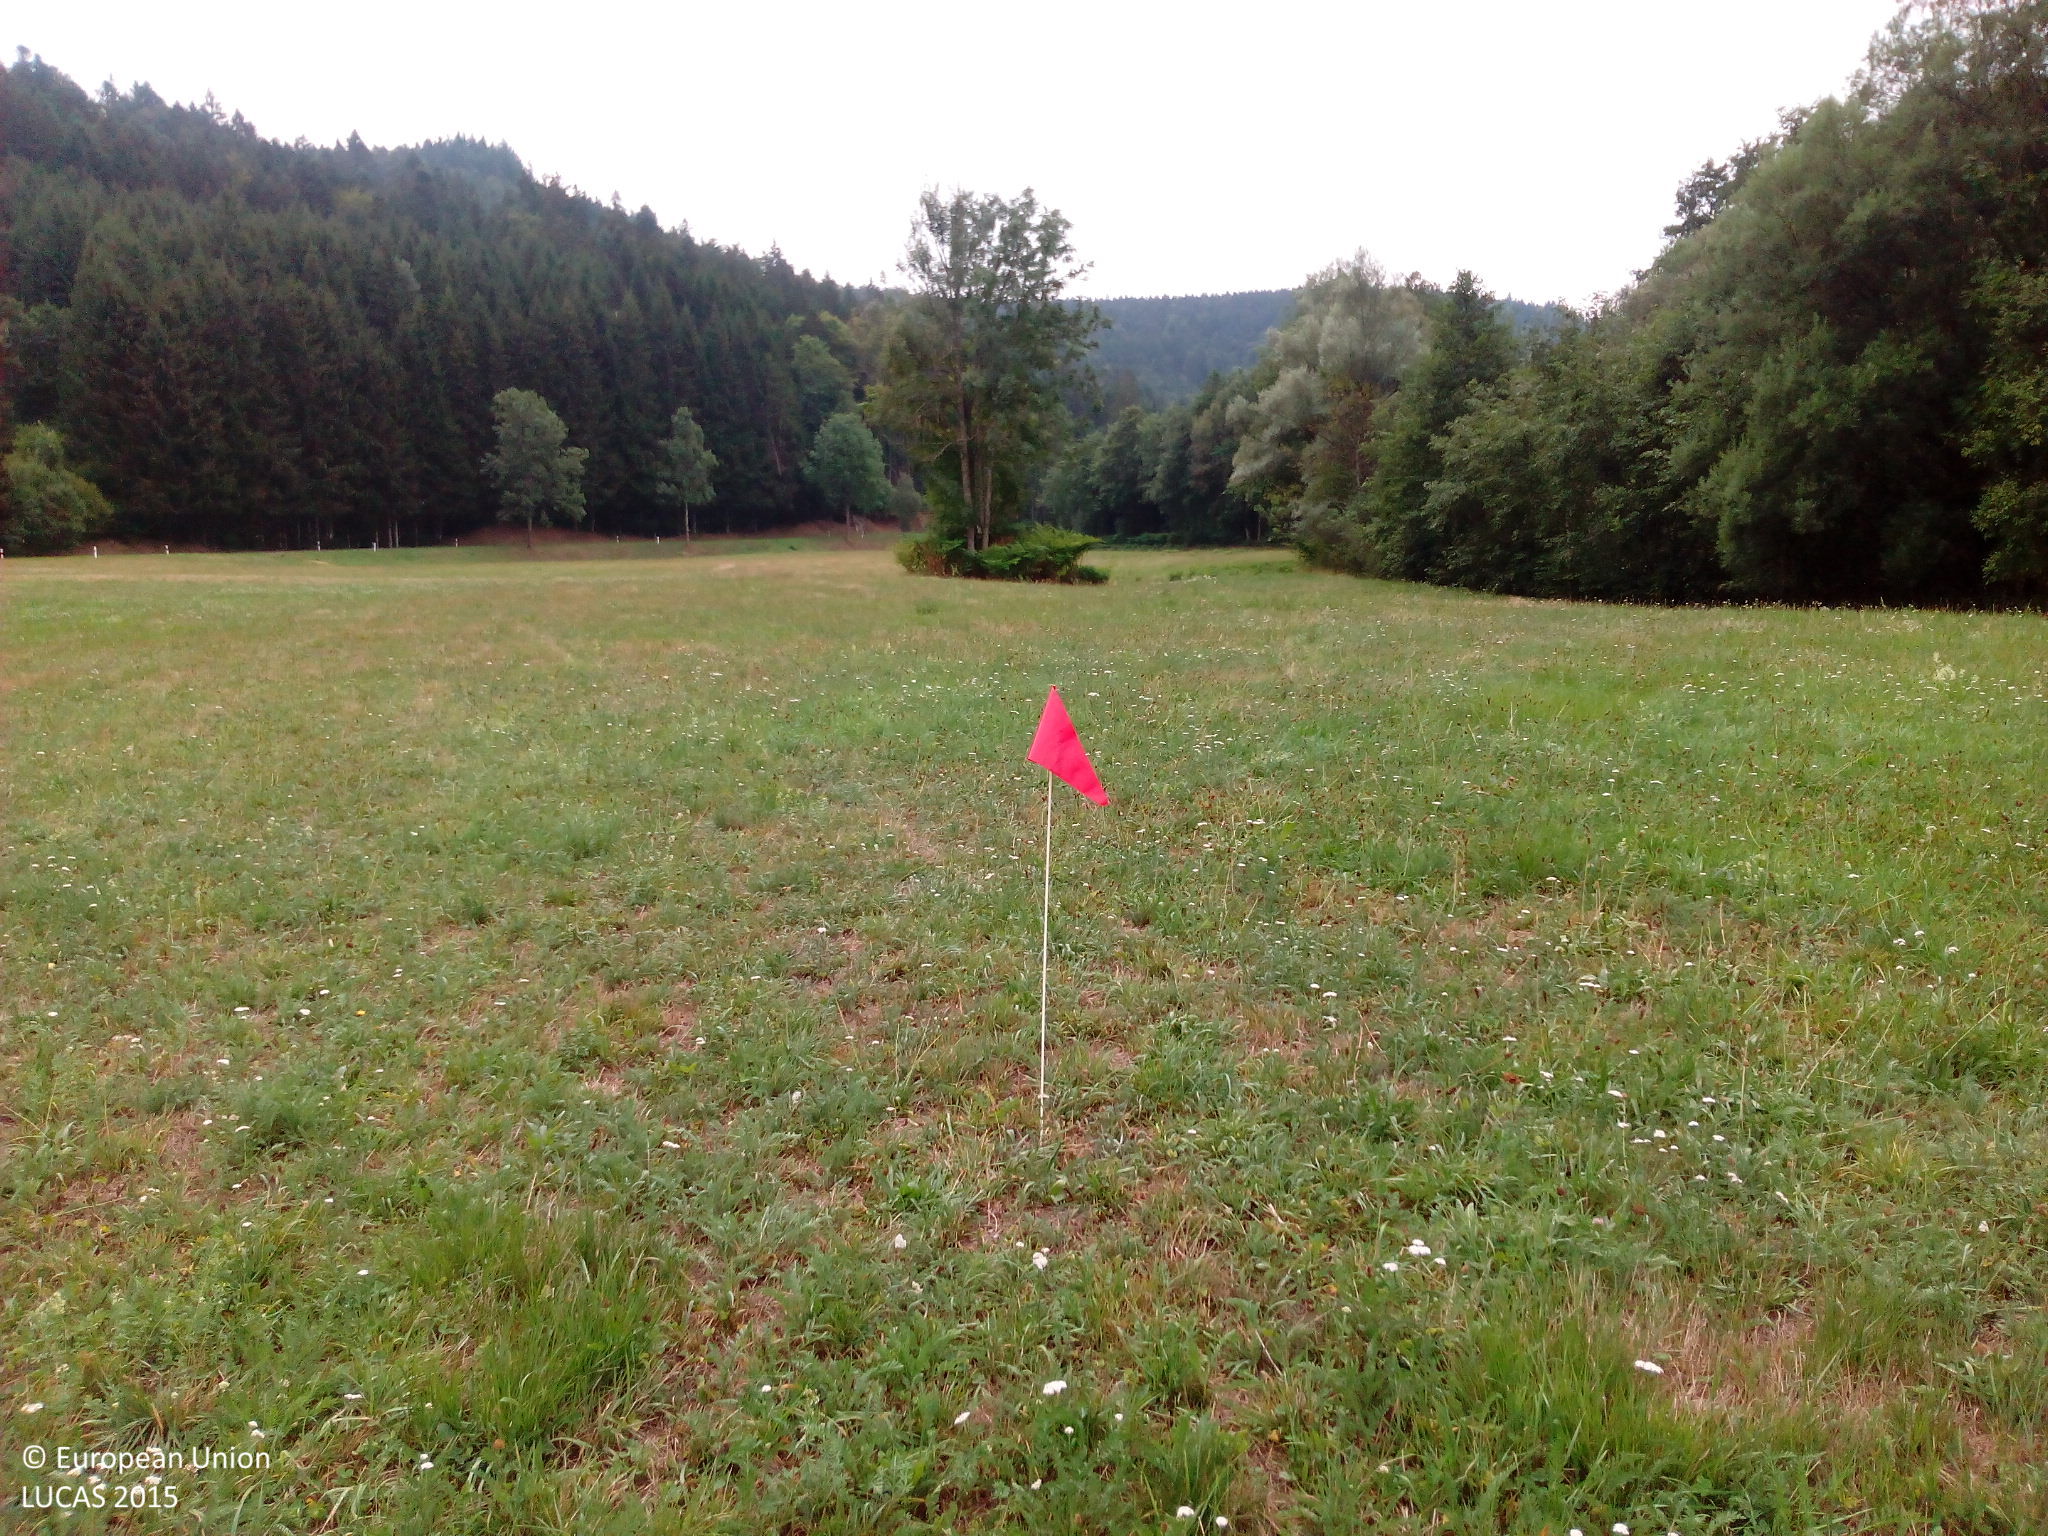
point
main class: Grassland
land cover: Grassland without tree/shrub cover
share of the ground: > 75 %
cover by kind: herbaceous plants 85 %, unconsolidated bare surface 15 %
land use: Agriculture (excluding fallow land and kitchen gardens)
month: August
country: DE
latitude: 47.6855
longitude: 8.1229
